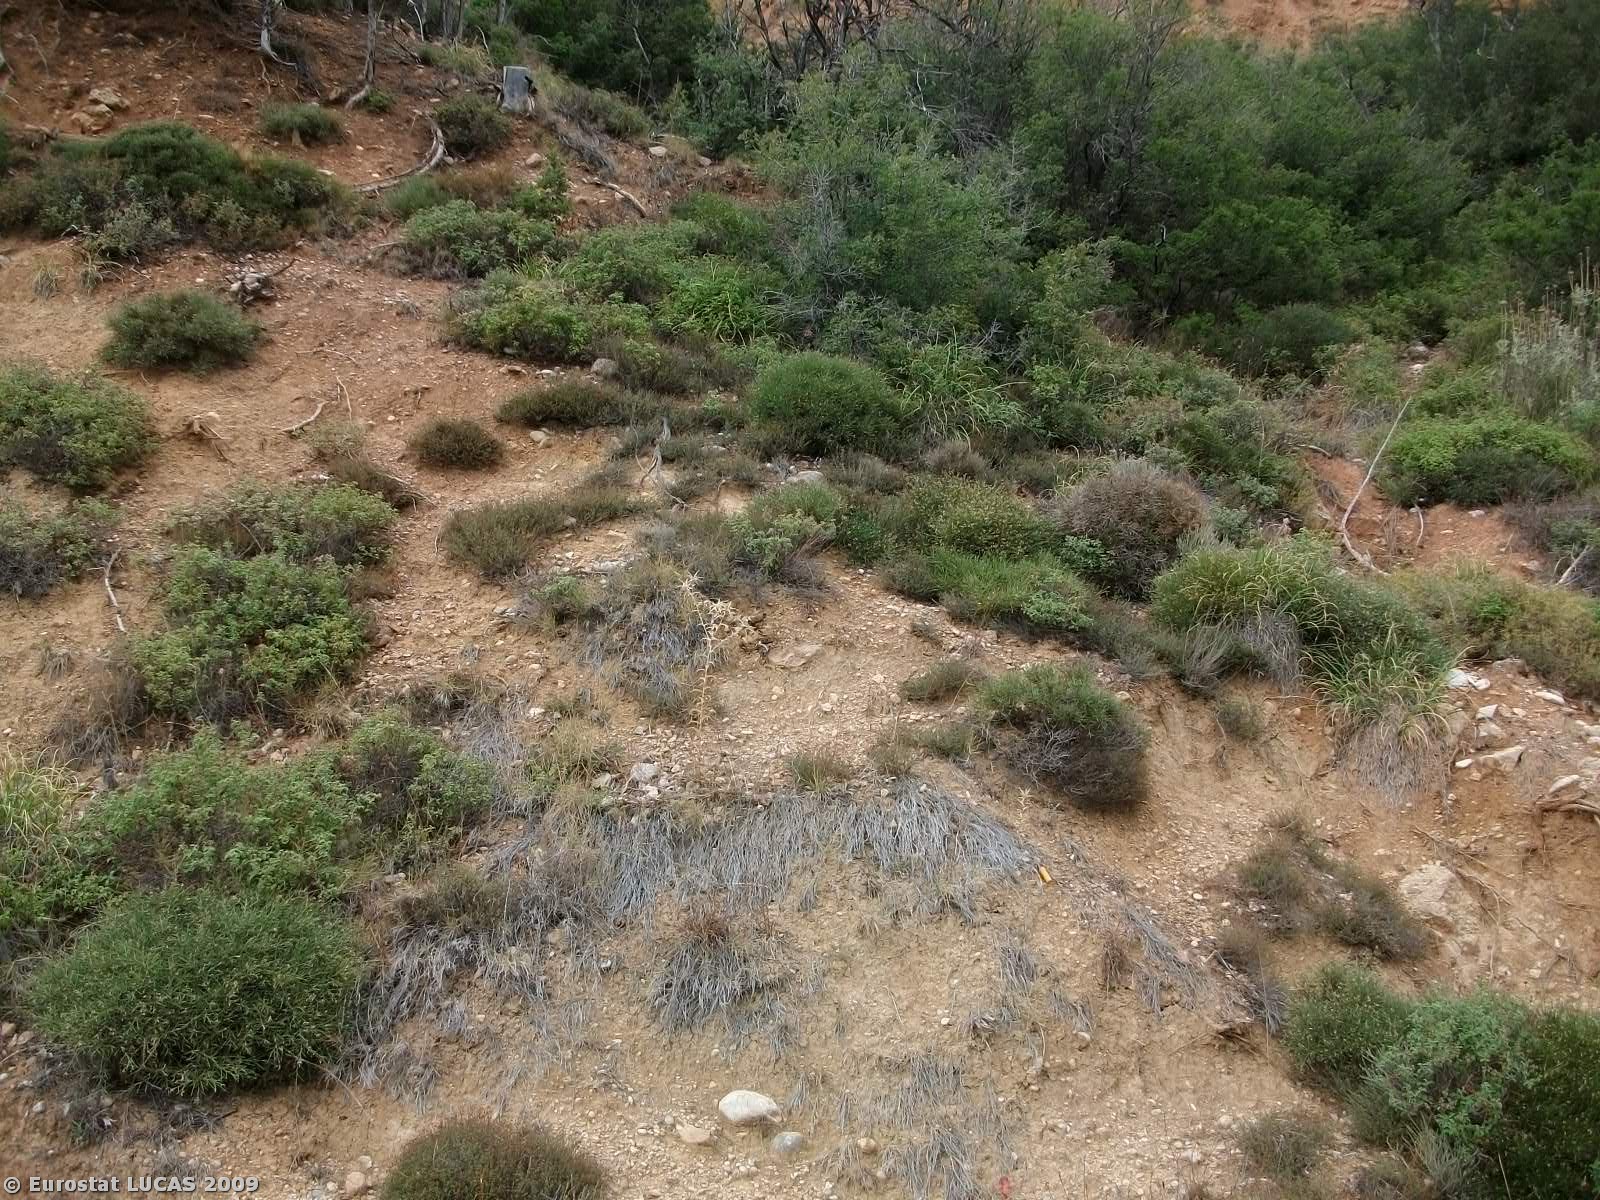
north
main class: Shrubland
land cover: Shrubland without tree cover
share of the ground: > 75 %
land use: Unused
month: September
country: GR
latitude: 38.0709
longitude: 22.5208
